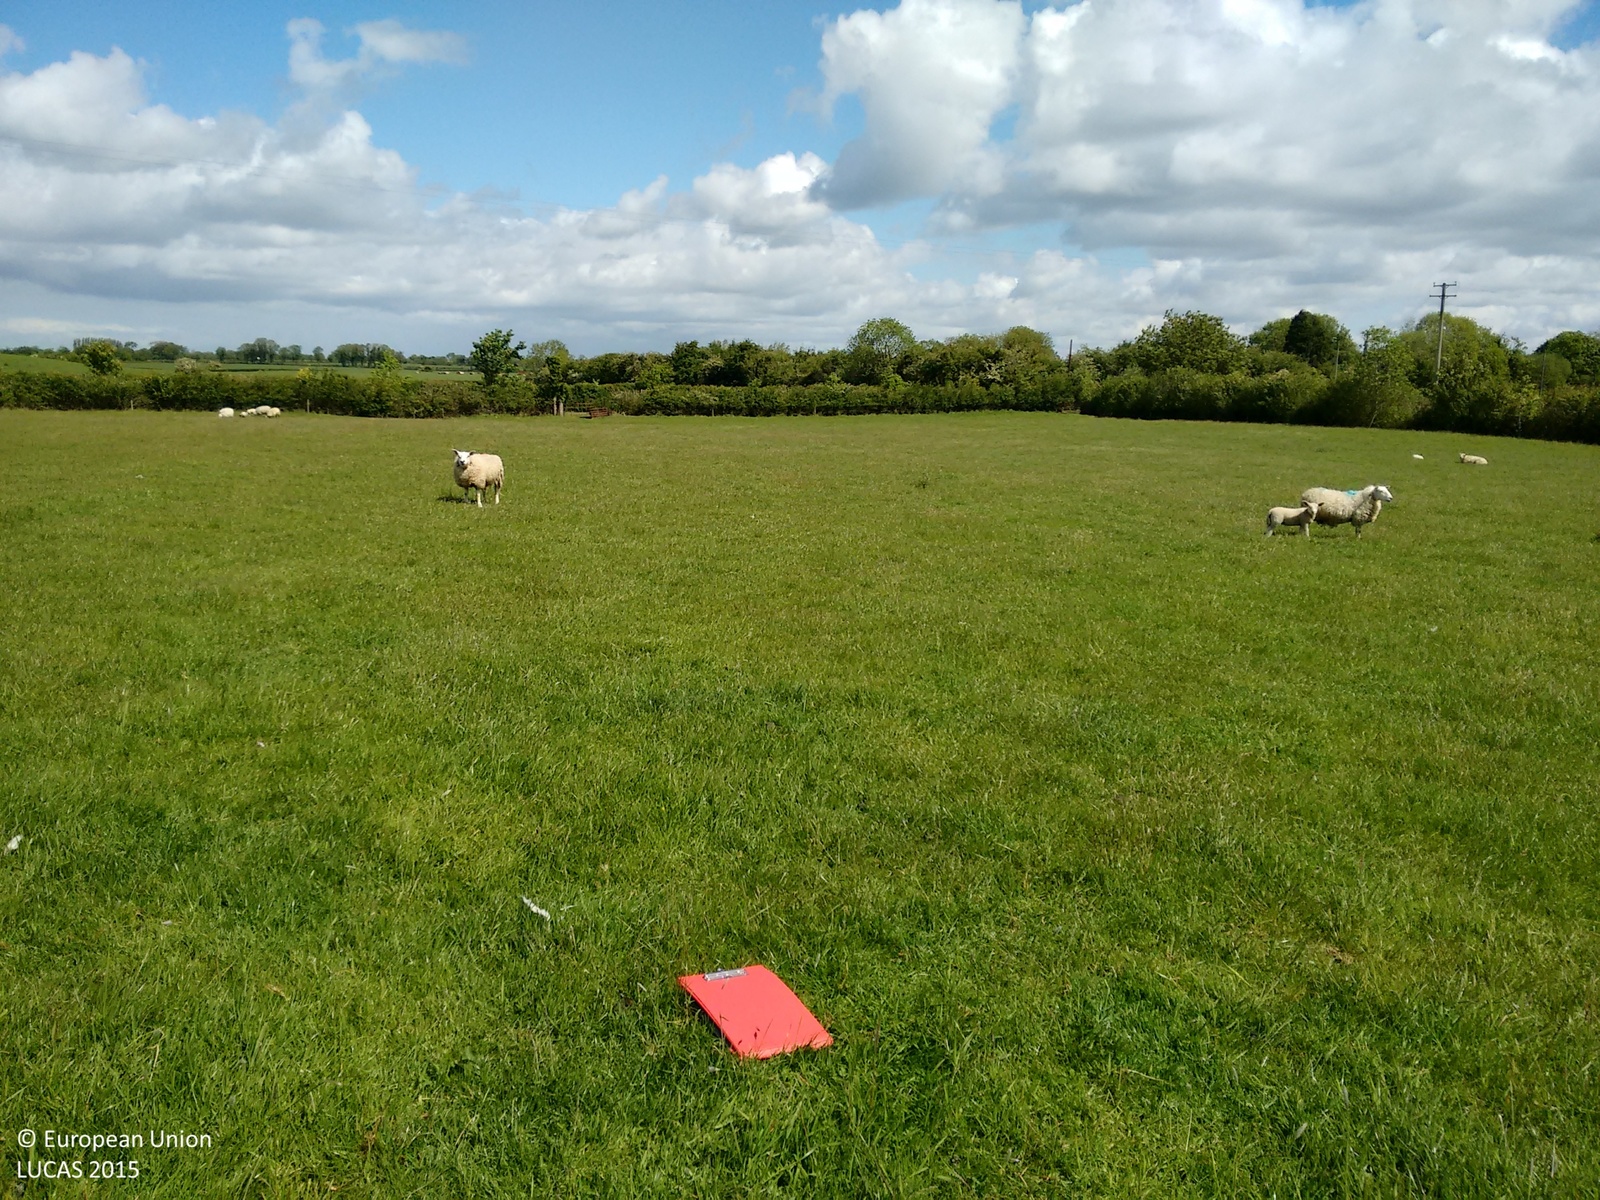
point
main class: Grassland
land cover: Grassland without tree/shrub cover
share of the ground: > 75 %
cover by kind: herbaceous plants 100 %
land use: Agriculture (excluding fallow land and kitchen gardens)
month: June
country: IE
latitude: 53.4400
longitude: -6.9872
